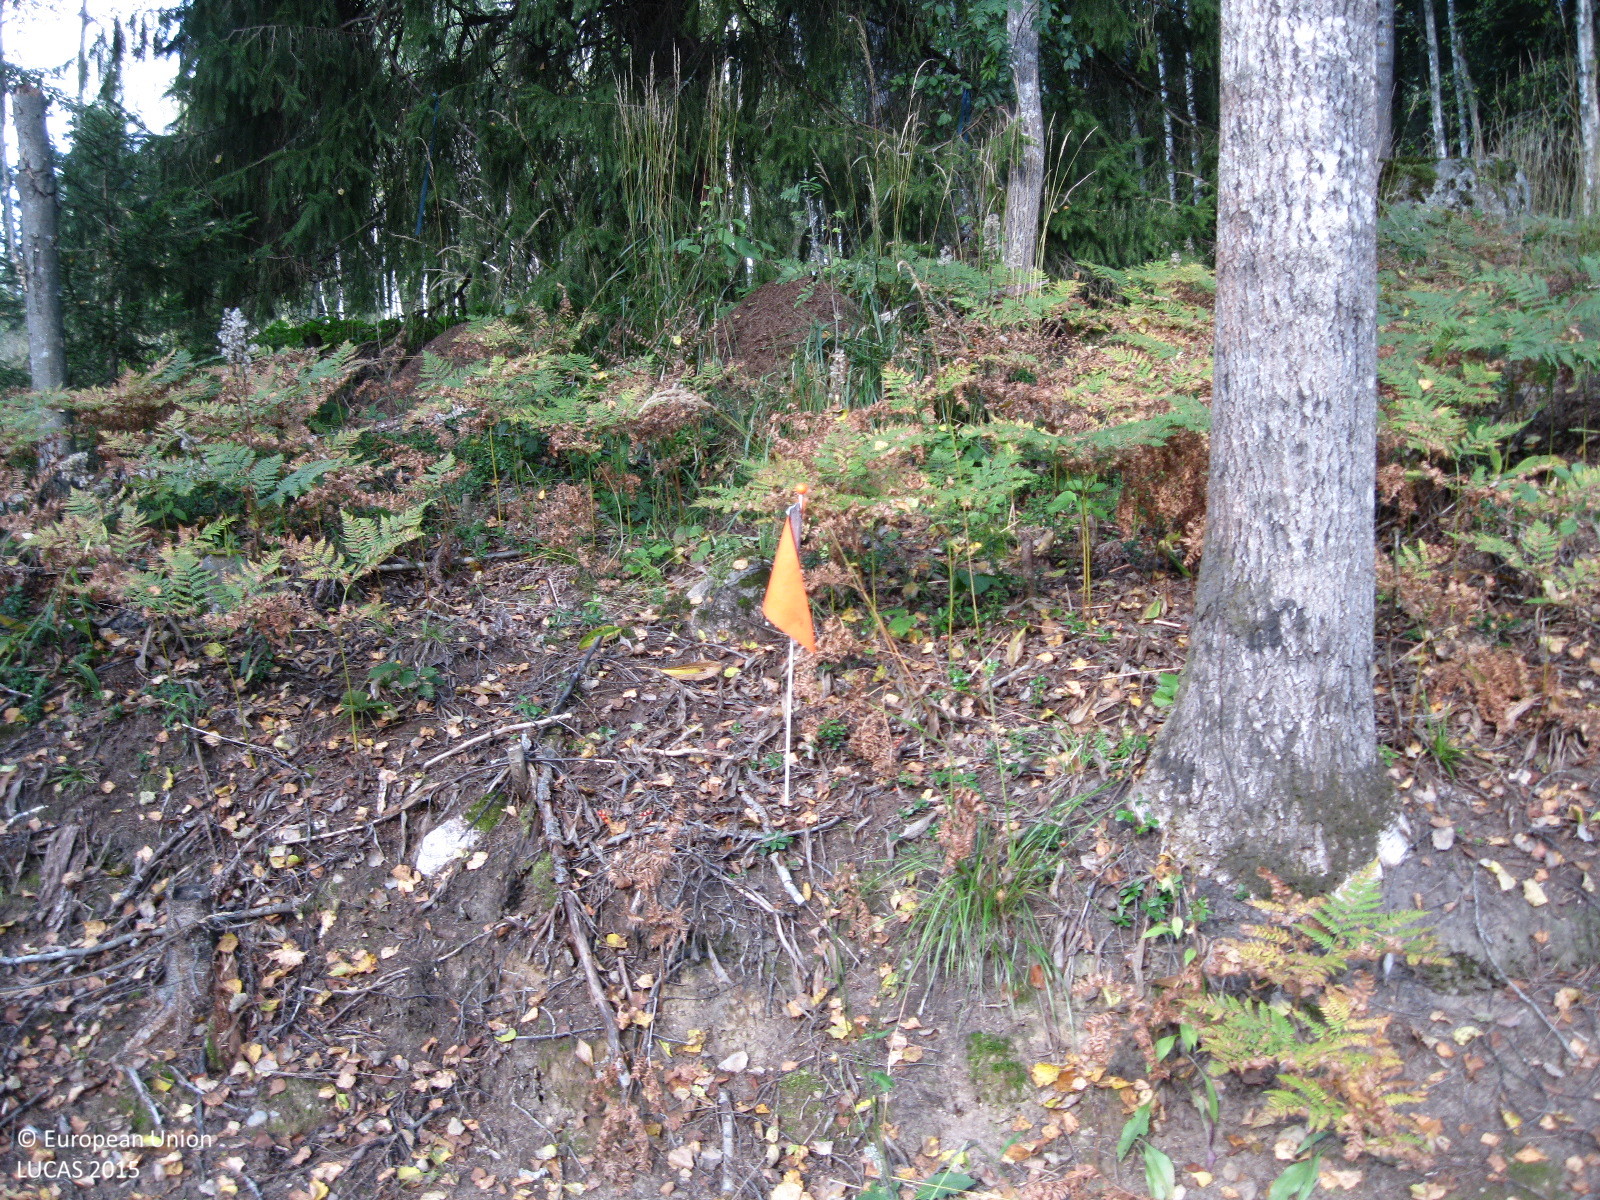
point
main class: Woodland
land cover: Broadleaved woodland
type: boreal forest
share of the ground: > 75 %
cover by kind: broadleaved forest trees 65 %, herbaceous plants 15 %, coniferous forest trees 10 %, unconsolidated bare surface 10 %
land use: Forestry
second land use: Amenities, museums, leisure
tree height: > 5 m
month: September
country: FI
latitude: 60.3421
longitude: 24.5111
